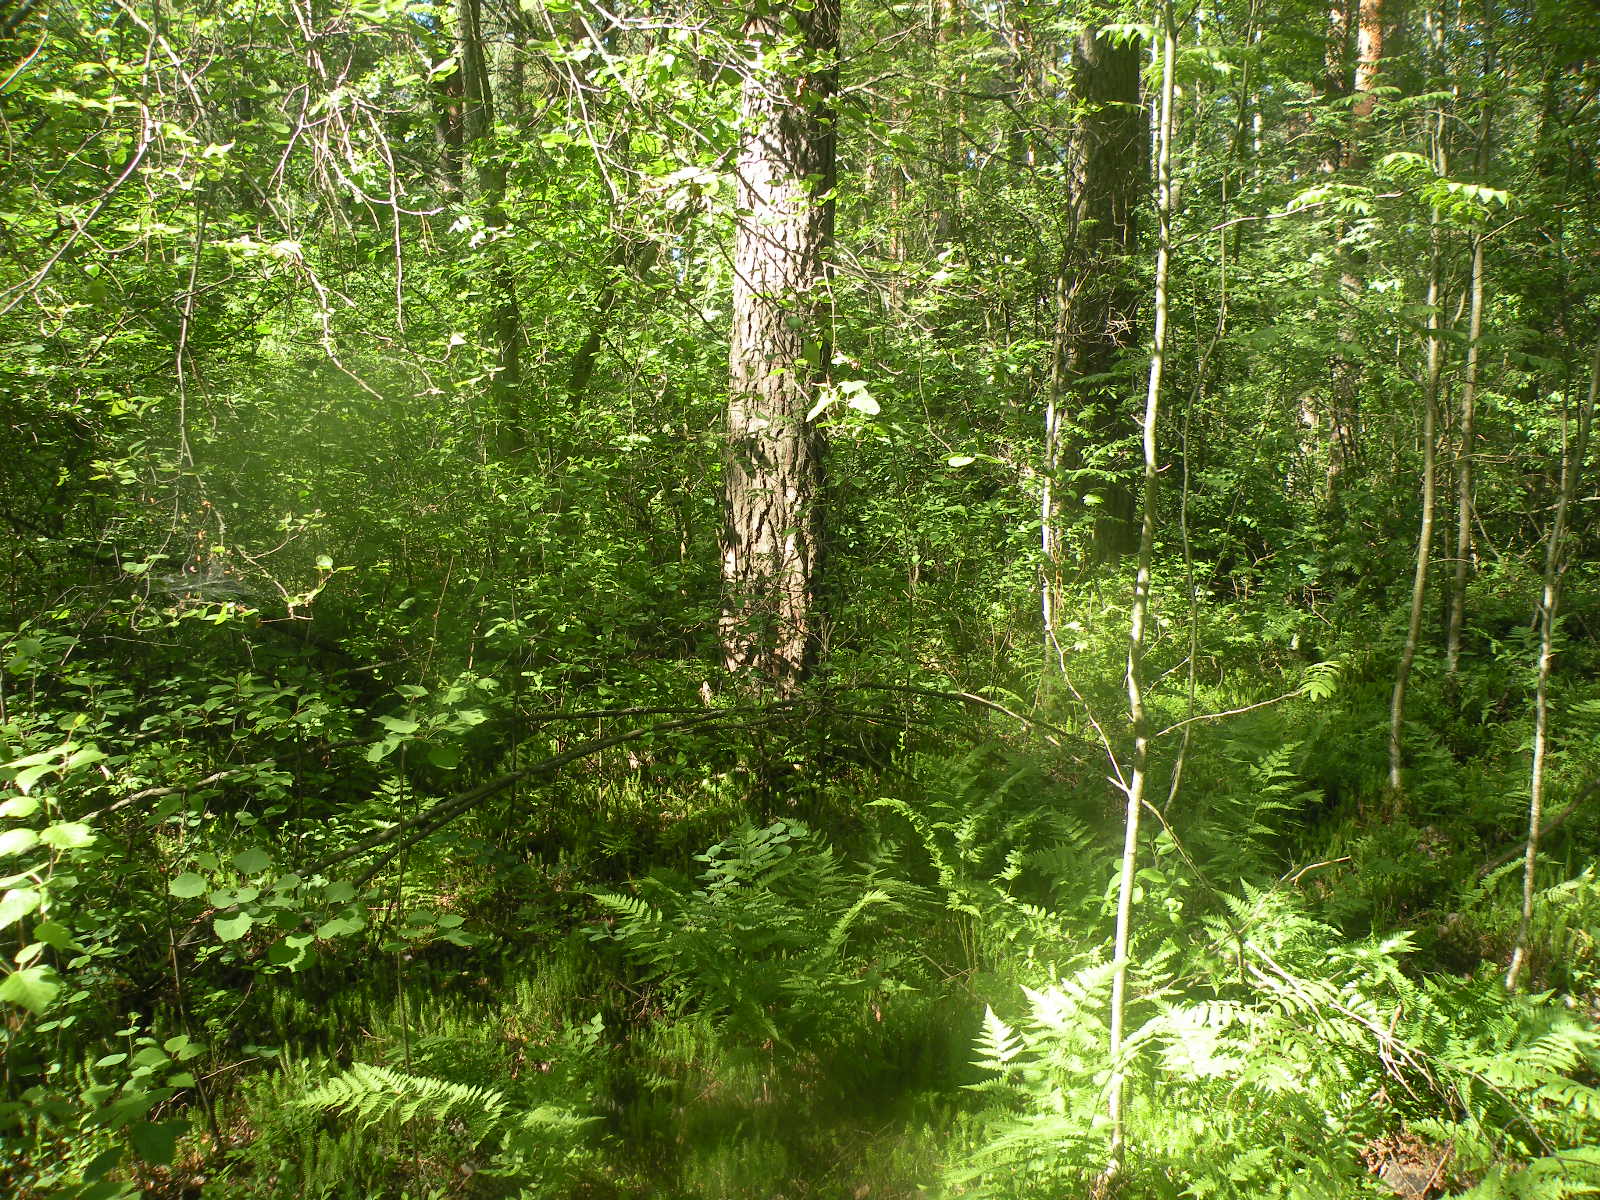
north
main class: Woodland
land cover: Pine dominated mixed woodland
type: hemiboreal forest and nemoral coniferous forest and mixed broadleaved-coniferous forest
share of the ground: > 75 %
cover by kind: coniferous forest trees 55 %, broadleaved forest trees 25 %, shrubs 10 %, herbaceous plants 10 %
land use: Forestry
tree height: > 5 m
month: June
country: LV
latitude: 55.8857
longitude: 26.6049
